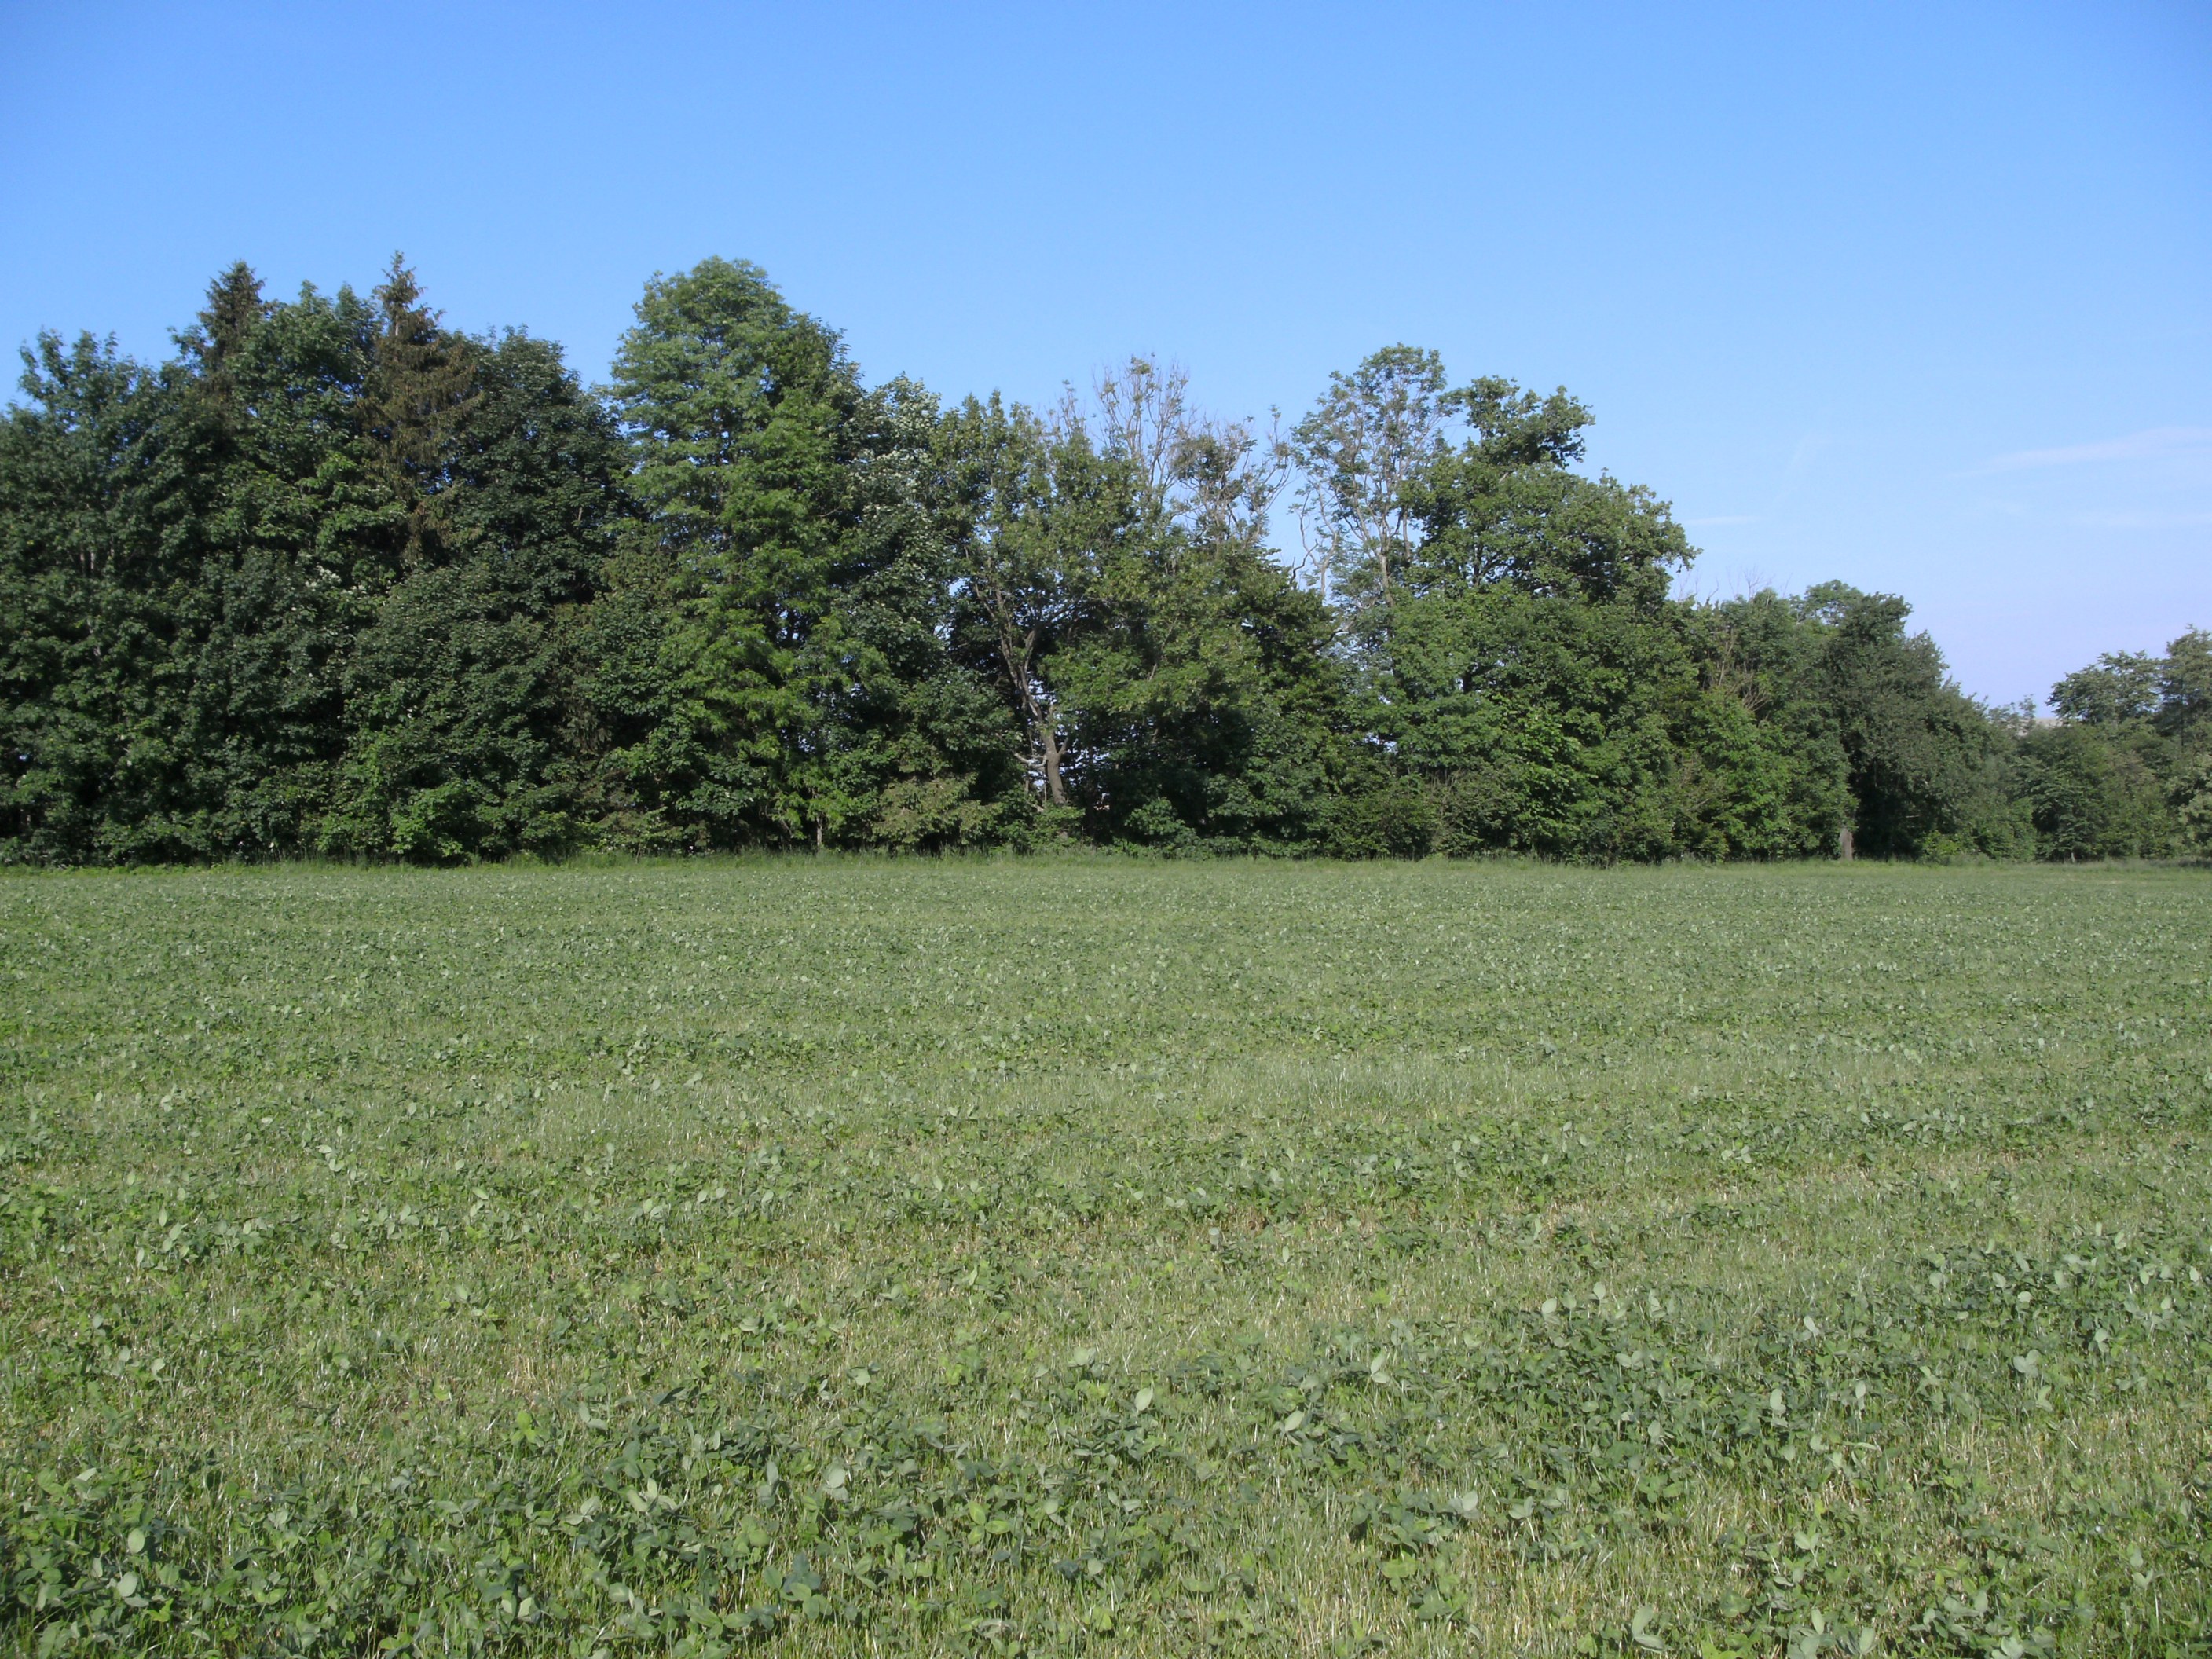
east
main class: Cropland
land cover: Other leguminous and mixtures for fodder
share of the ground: > 75 %
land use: Agriculture (excluding fallow land and kitchen gardens)
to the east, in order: Other leguminous and mixtures for fodder; Broadleaved woodland; Rivers and streams; Broadleaved woodland; Grassland without tree/shrub cover; Barley
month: May
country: AT
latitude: 48.1634
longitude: 13.6429
